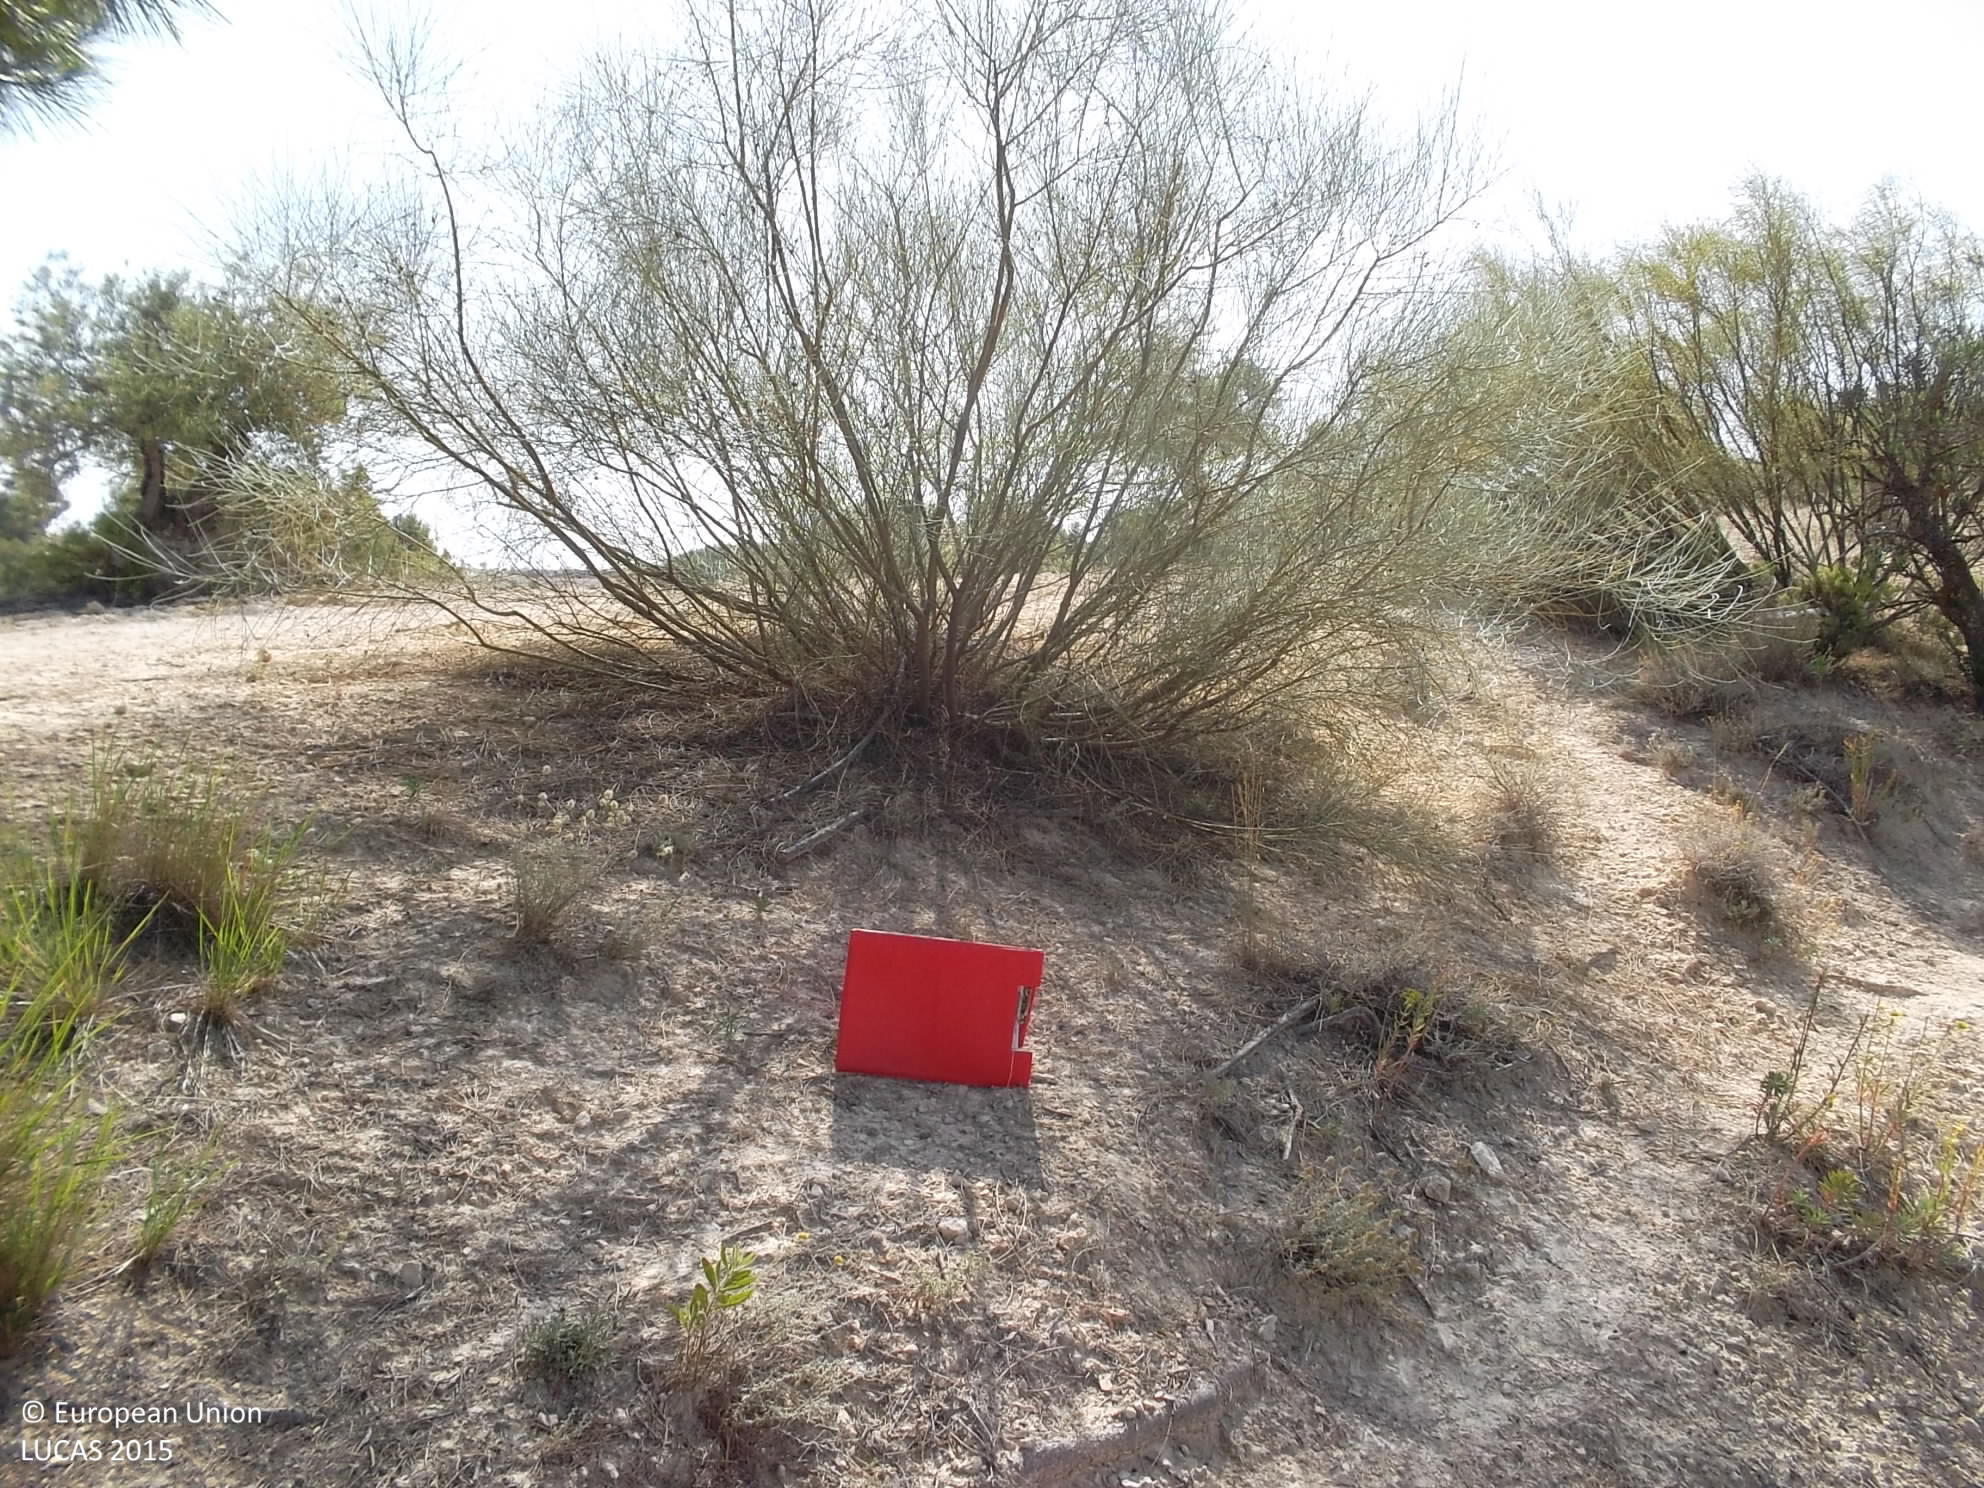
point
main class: Cropland
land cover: Olive groves
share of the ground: 10 - 25 %
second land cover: Spontaneously vegetated surfaces
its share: 25 - 50 %
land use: Agriculture (excluding fallow land and kitchen gardens)
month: June
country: ES
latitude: 37.7340
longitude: -2.8474
